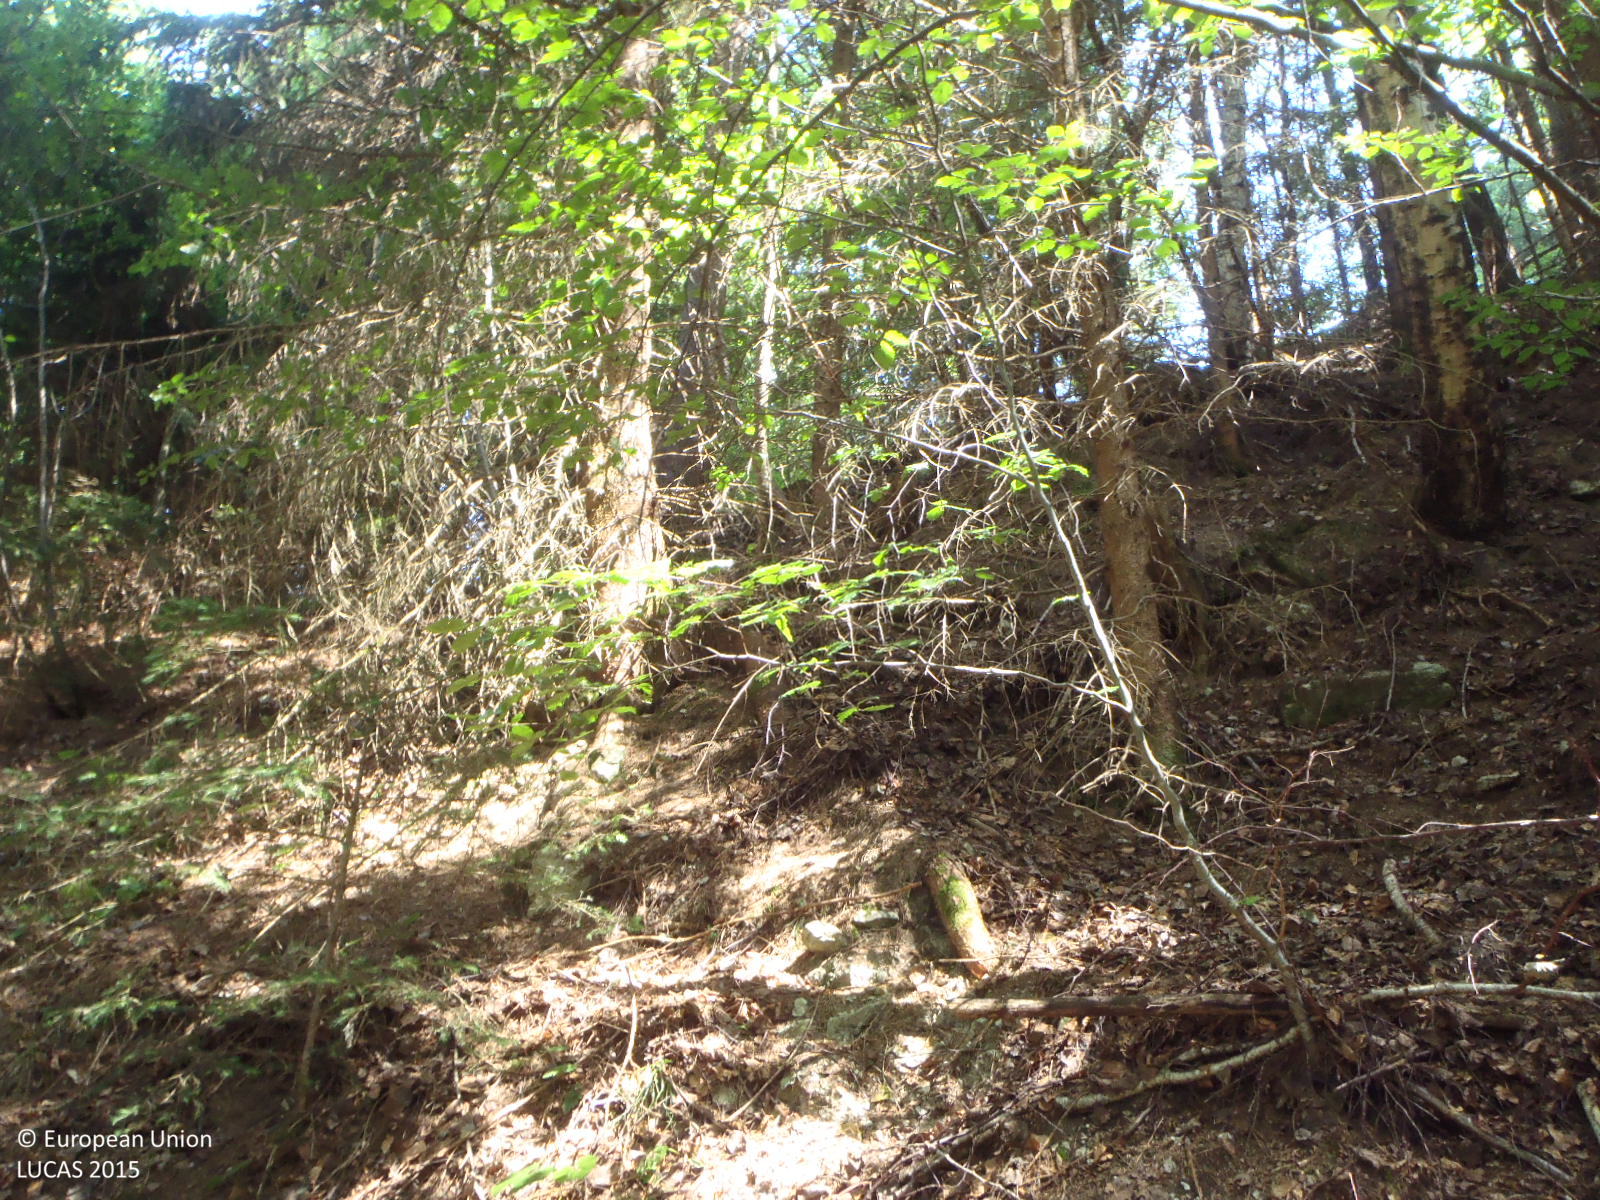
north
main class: Woodland
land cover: Spruce dominated mixed woodland
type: alpine coniferous forest
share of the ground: > 75 %
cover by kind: coniferous forest trees 60 %, broadleaved forest trees 30 %, shrubs 10 %
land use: Forestry
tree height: > 5 m
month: July
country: AT
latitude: 47.4592
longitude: 12.3993
